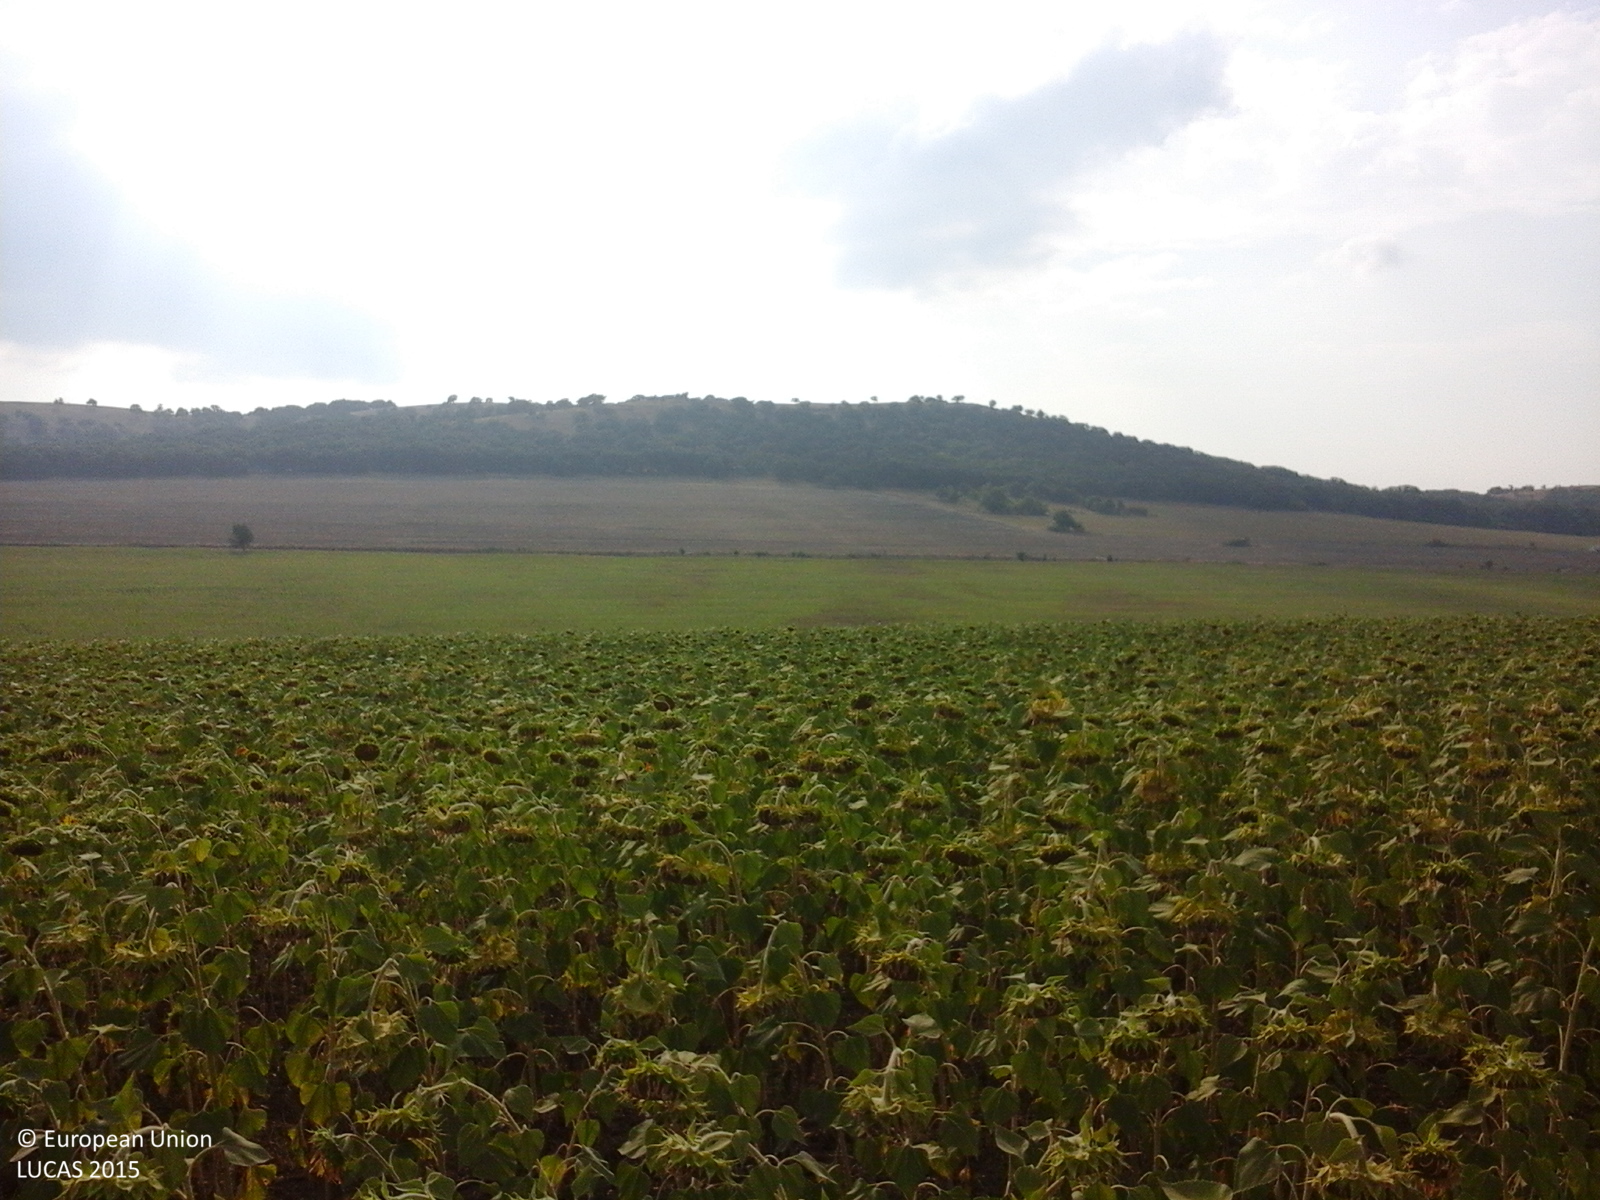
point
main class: Cropland
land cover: Sunflower
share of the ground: > 75 %
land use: Agriculture (excluding fallow land and kitchen gardens)
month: July
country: RO
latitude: 45.0990
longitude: 28.4398
